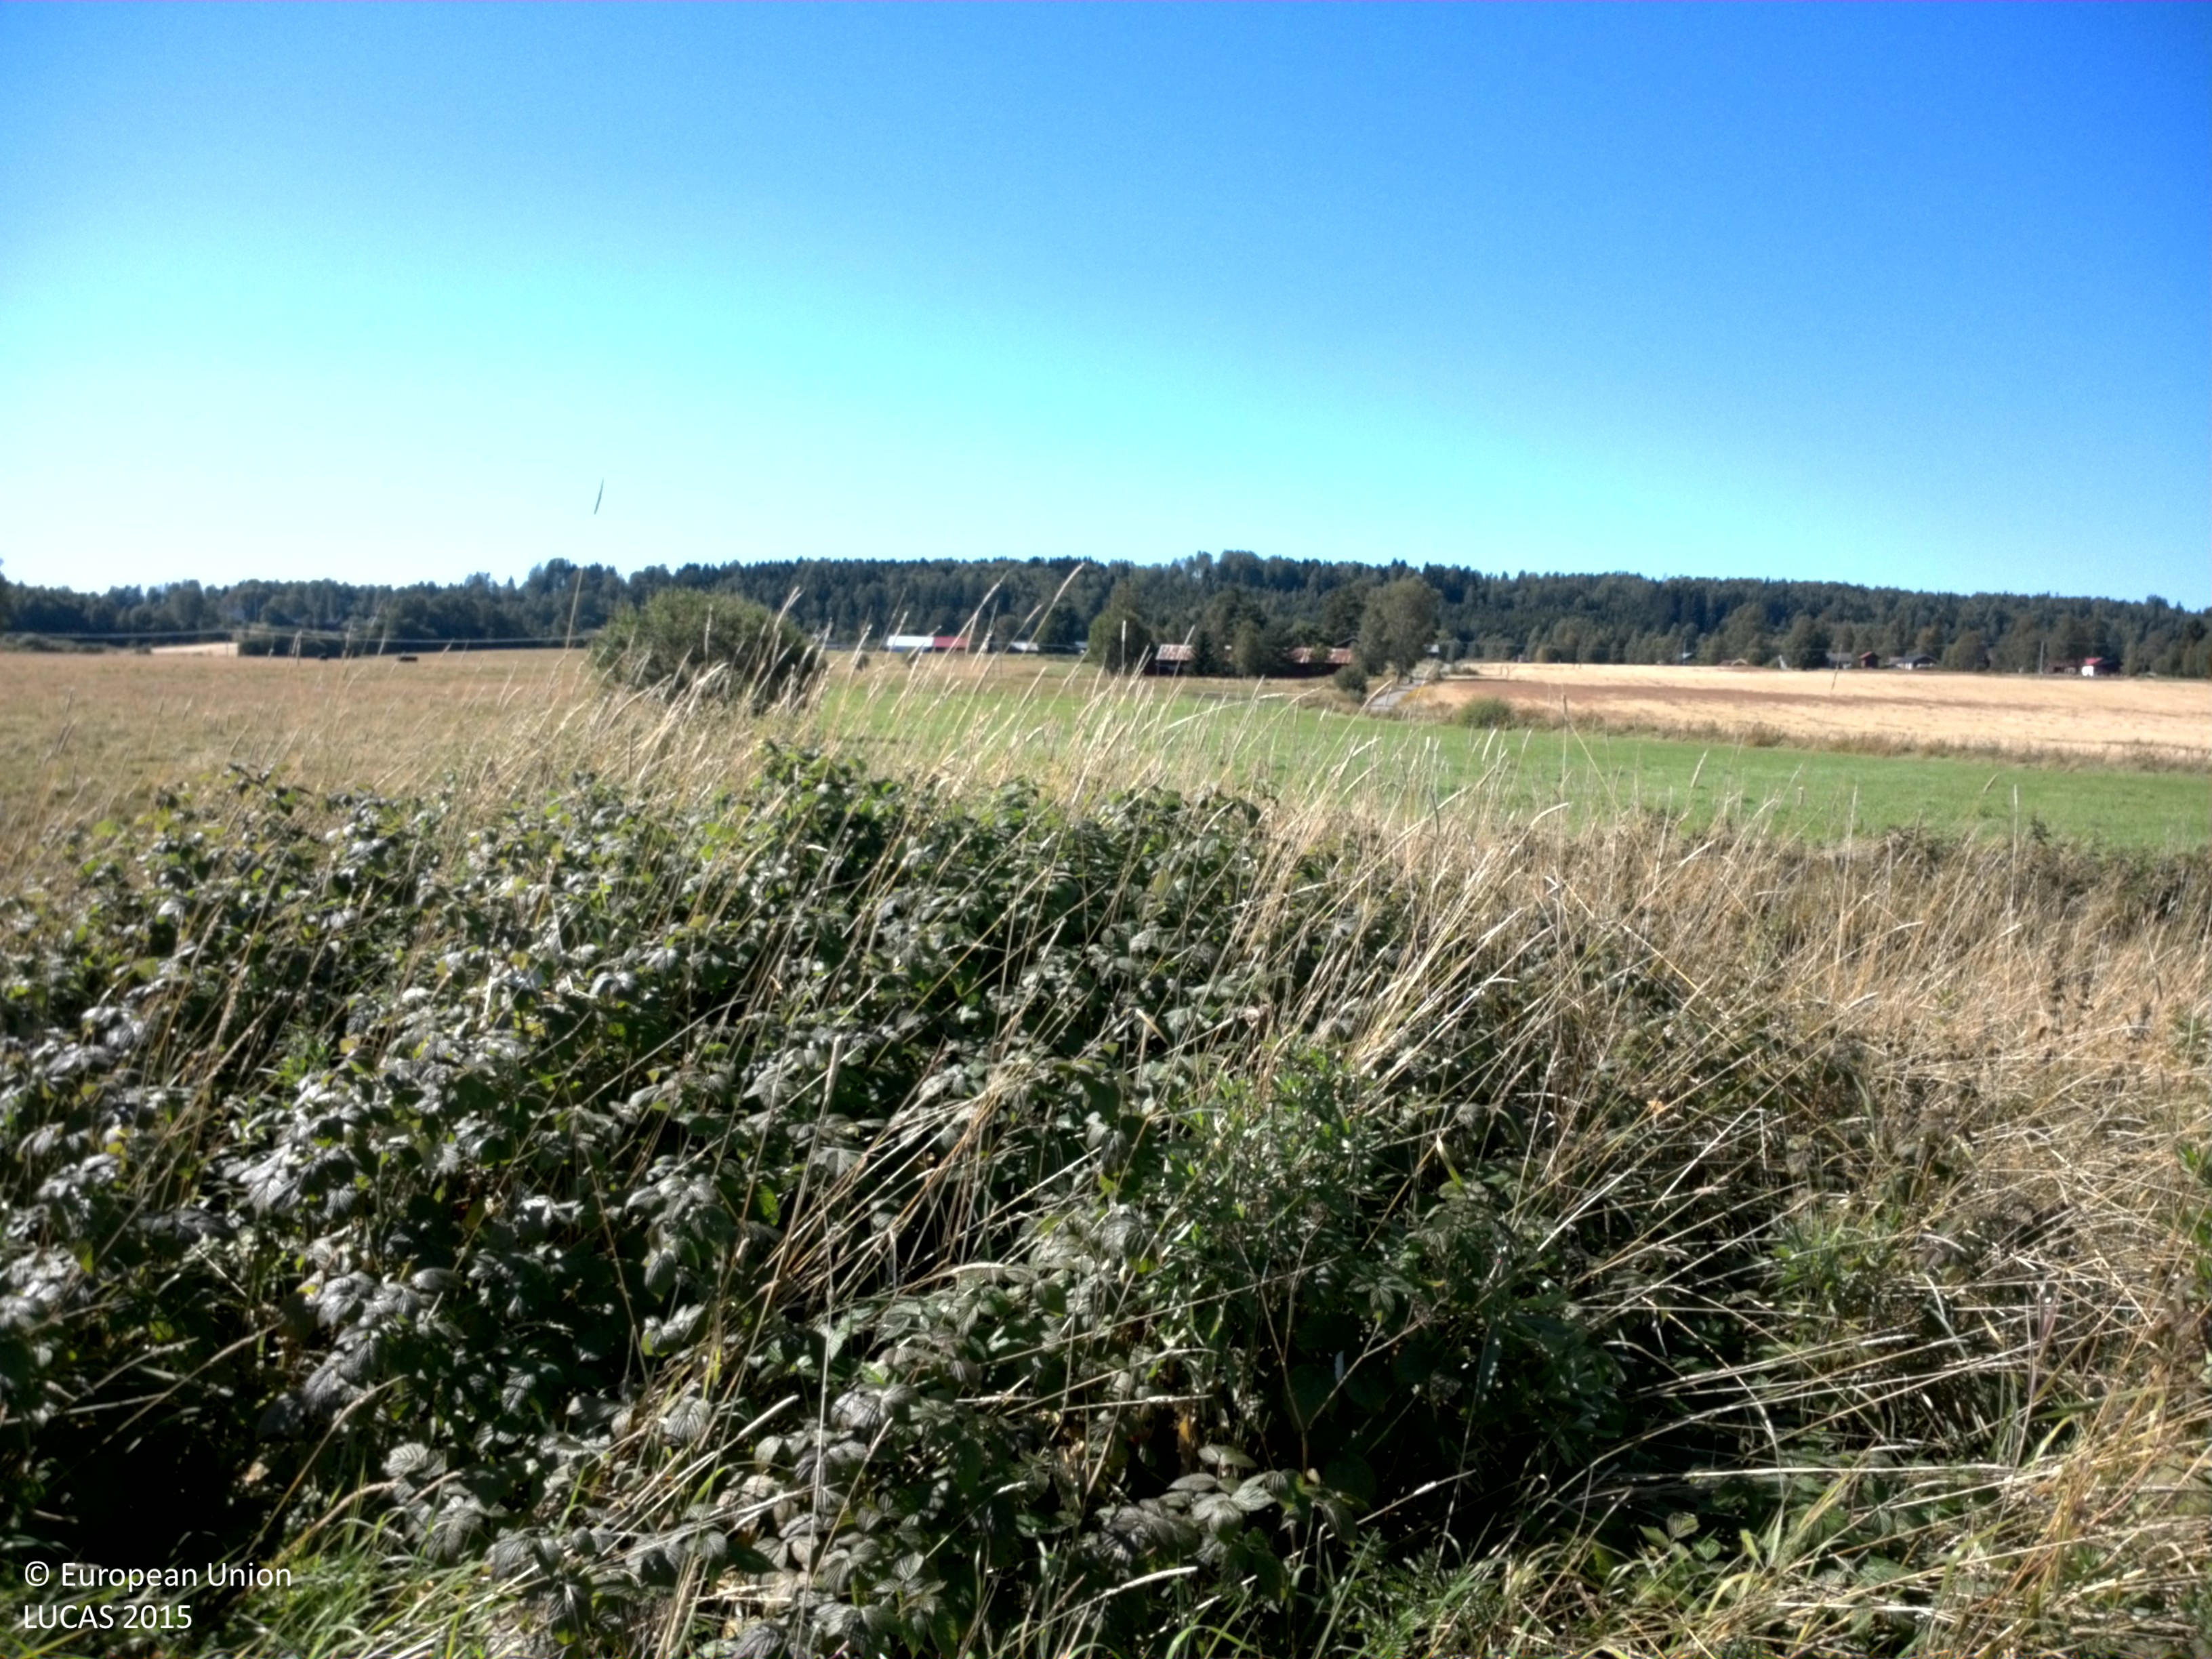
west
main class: Grassland
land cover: Grassland without tree/shrub cover
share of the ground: > 75 %
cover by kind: herbaceous plants 95 %, consolidated bare surface 5 %
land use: Agriculture (excluding fallow land and kitchen gardens)
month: August
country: SE
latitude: 59.8744
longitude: 13.1890
